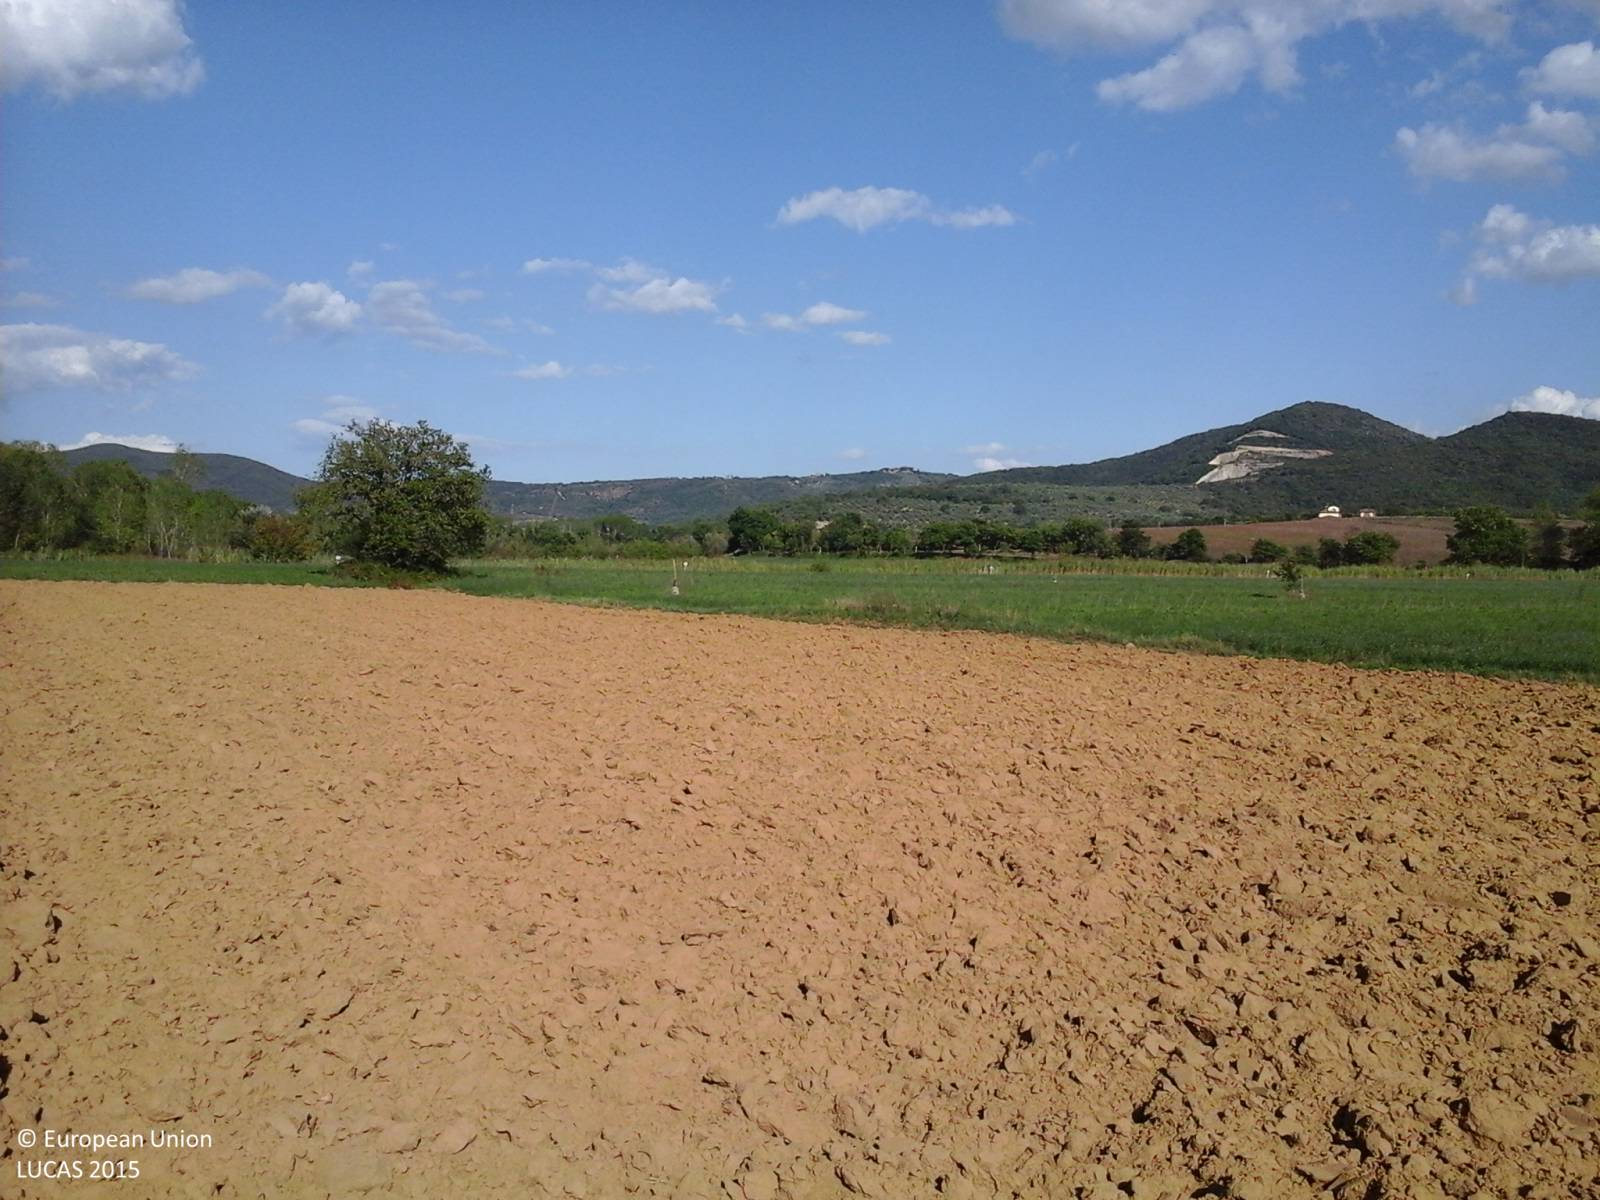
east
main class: Cropland
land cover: Common wheat
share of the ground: < 10 %
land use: Agriculture (excluding fallow land and kitchen gardens)
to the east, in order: Common wheat; Ditches and canals; Lucerne; Ditches and canals; Lucerne; Ditches and canals; Spontaneously vegetated surfaces; Shruby margins; Rivers and streams; Shruby margins; Lucerne
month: September
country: IT
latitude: 43.0474
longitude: 12.1175
